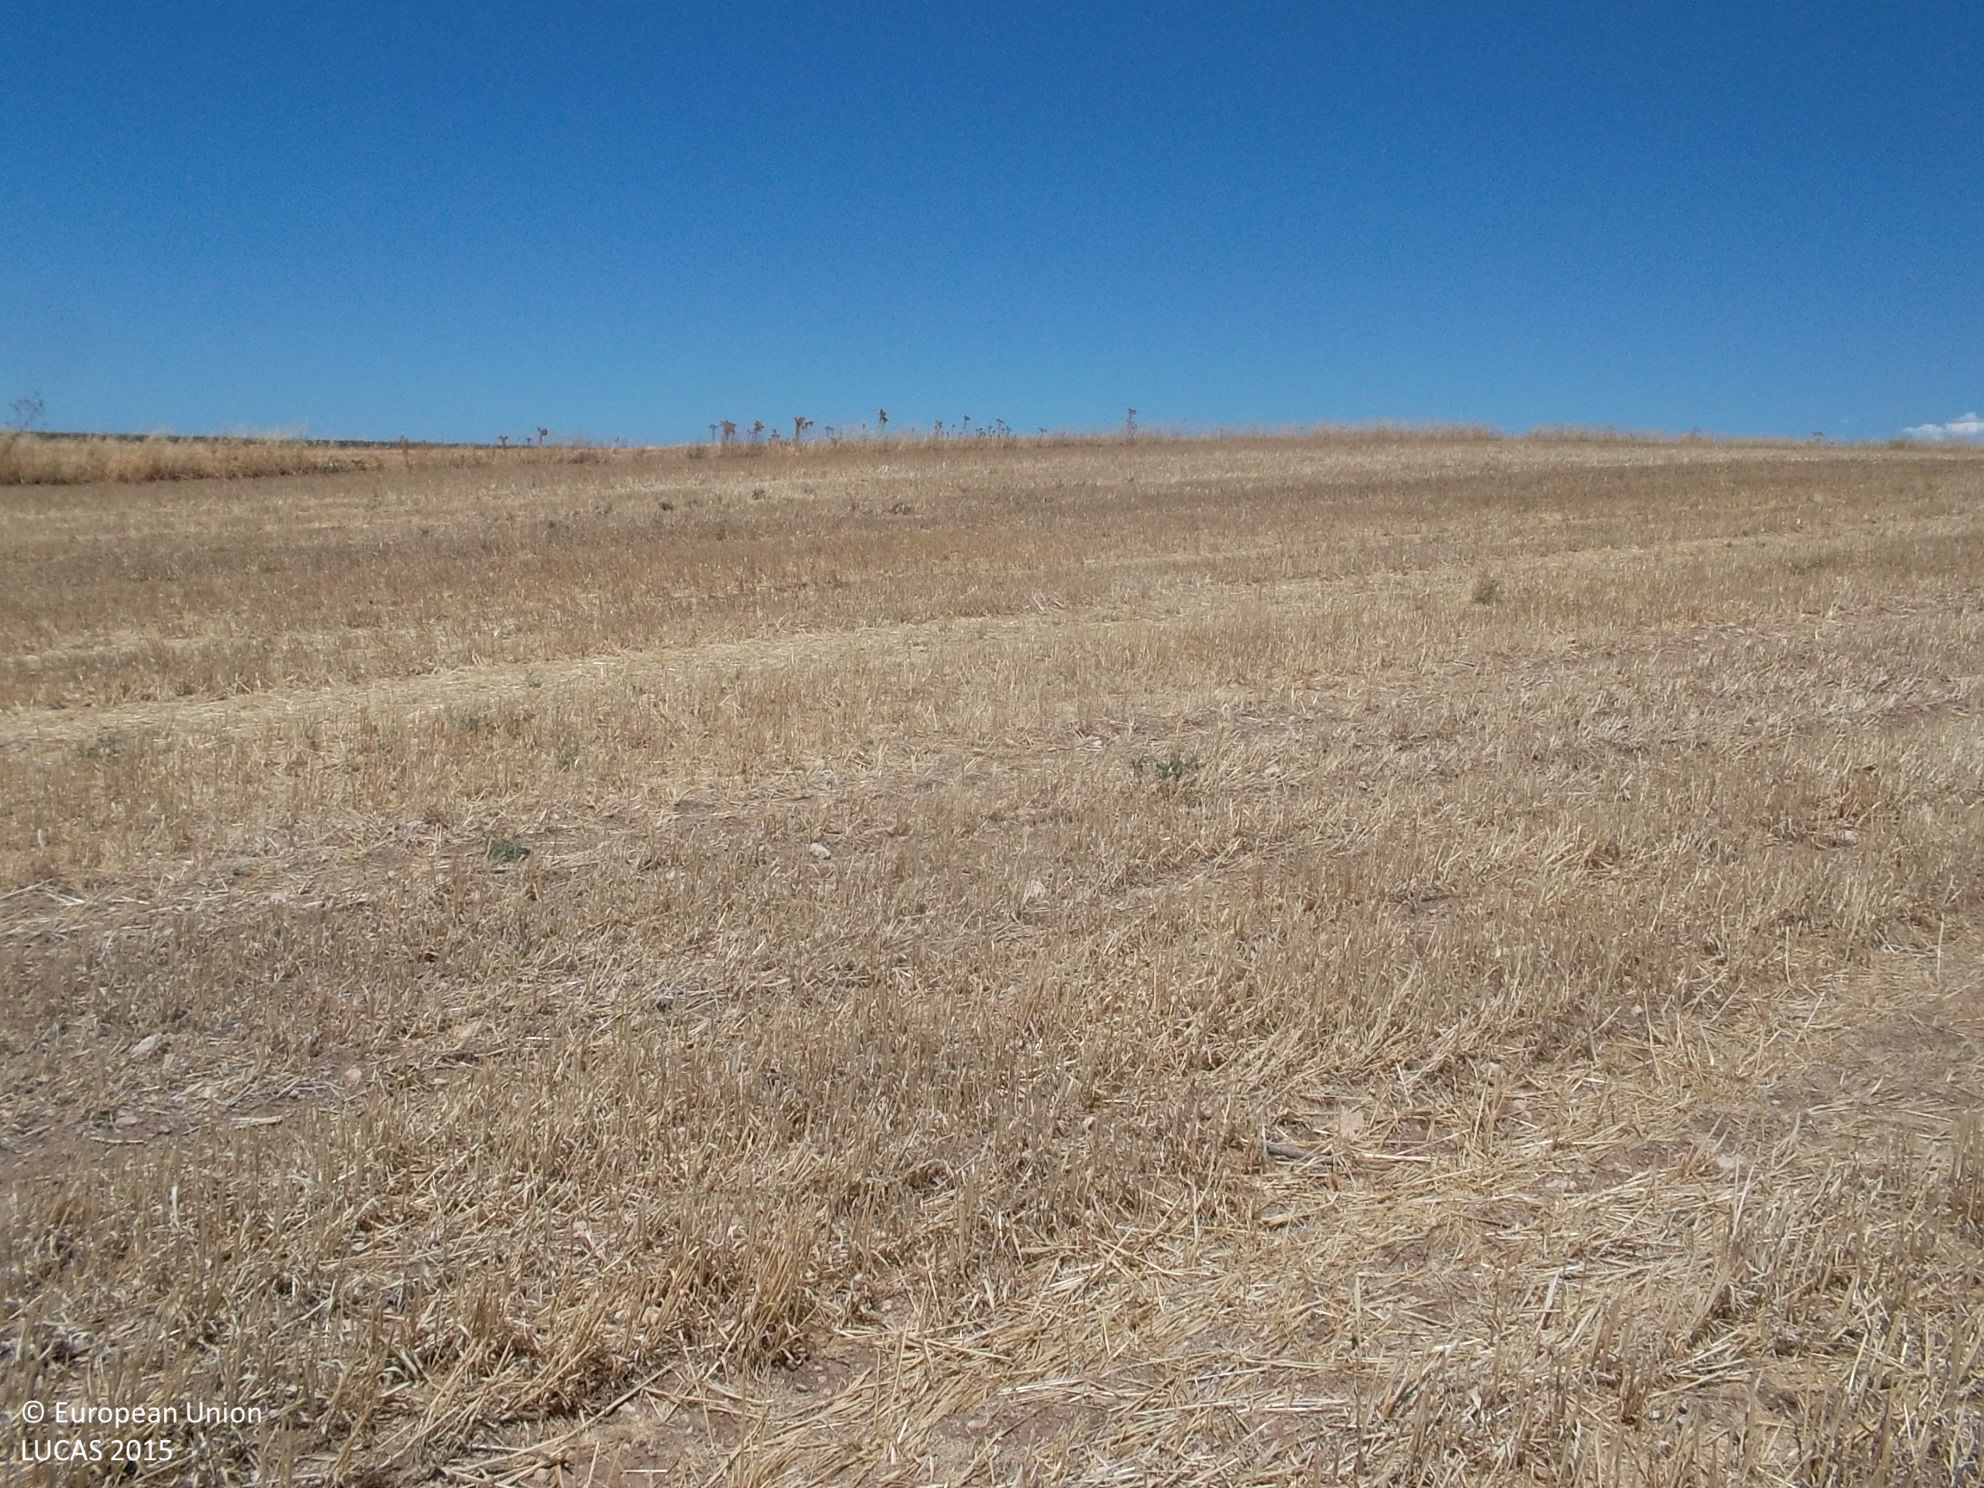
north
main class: Cropland
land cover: Barley
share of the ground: < 10 %
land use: Agriculture (excluding fallow land and kitchen gardens)
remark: Harvested field
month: July
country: ES
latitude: 38.3390
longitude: -5.7684
